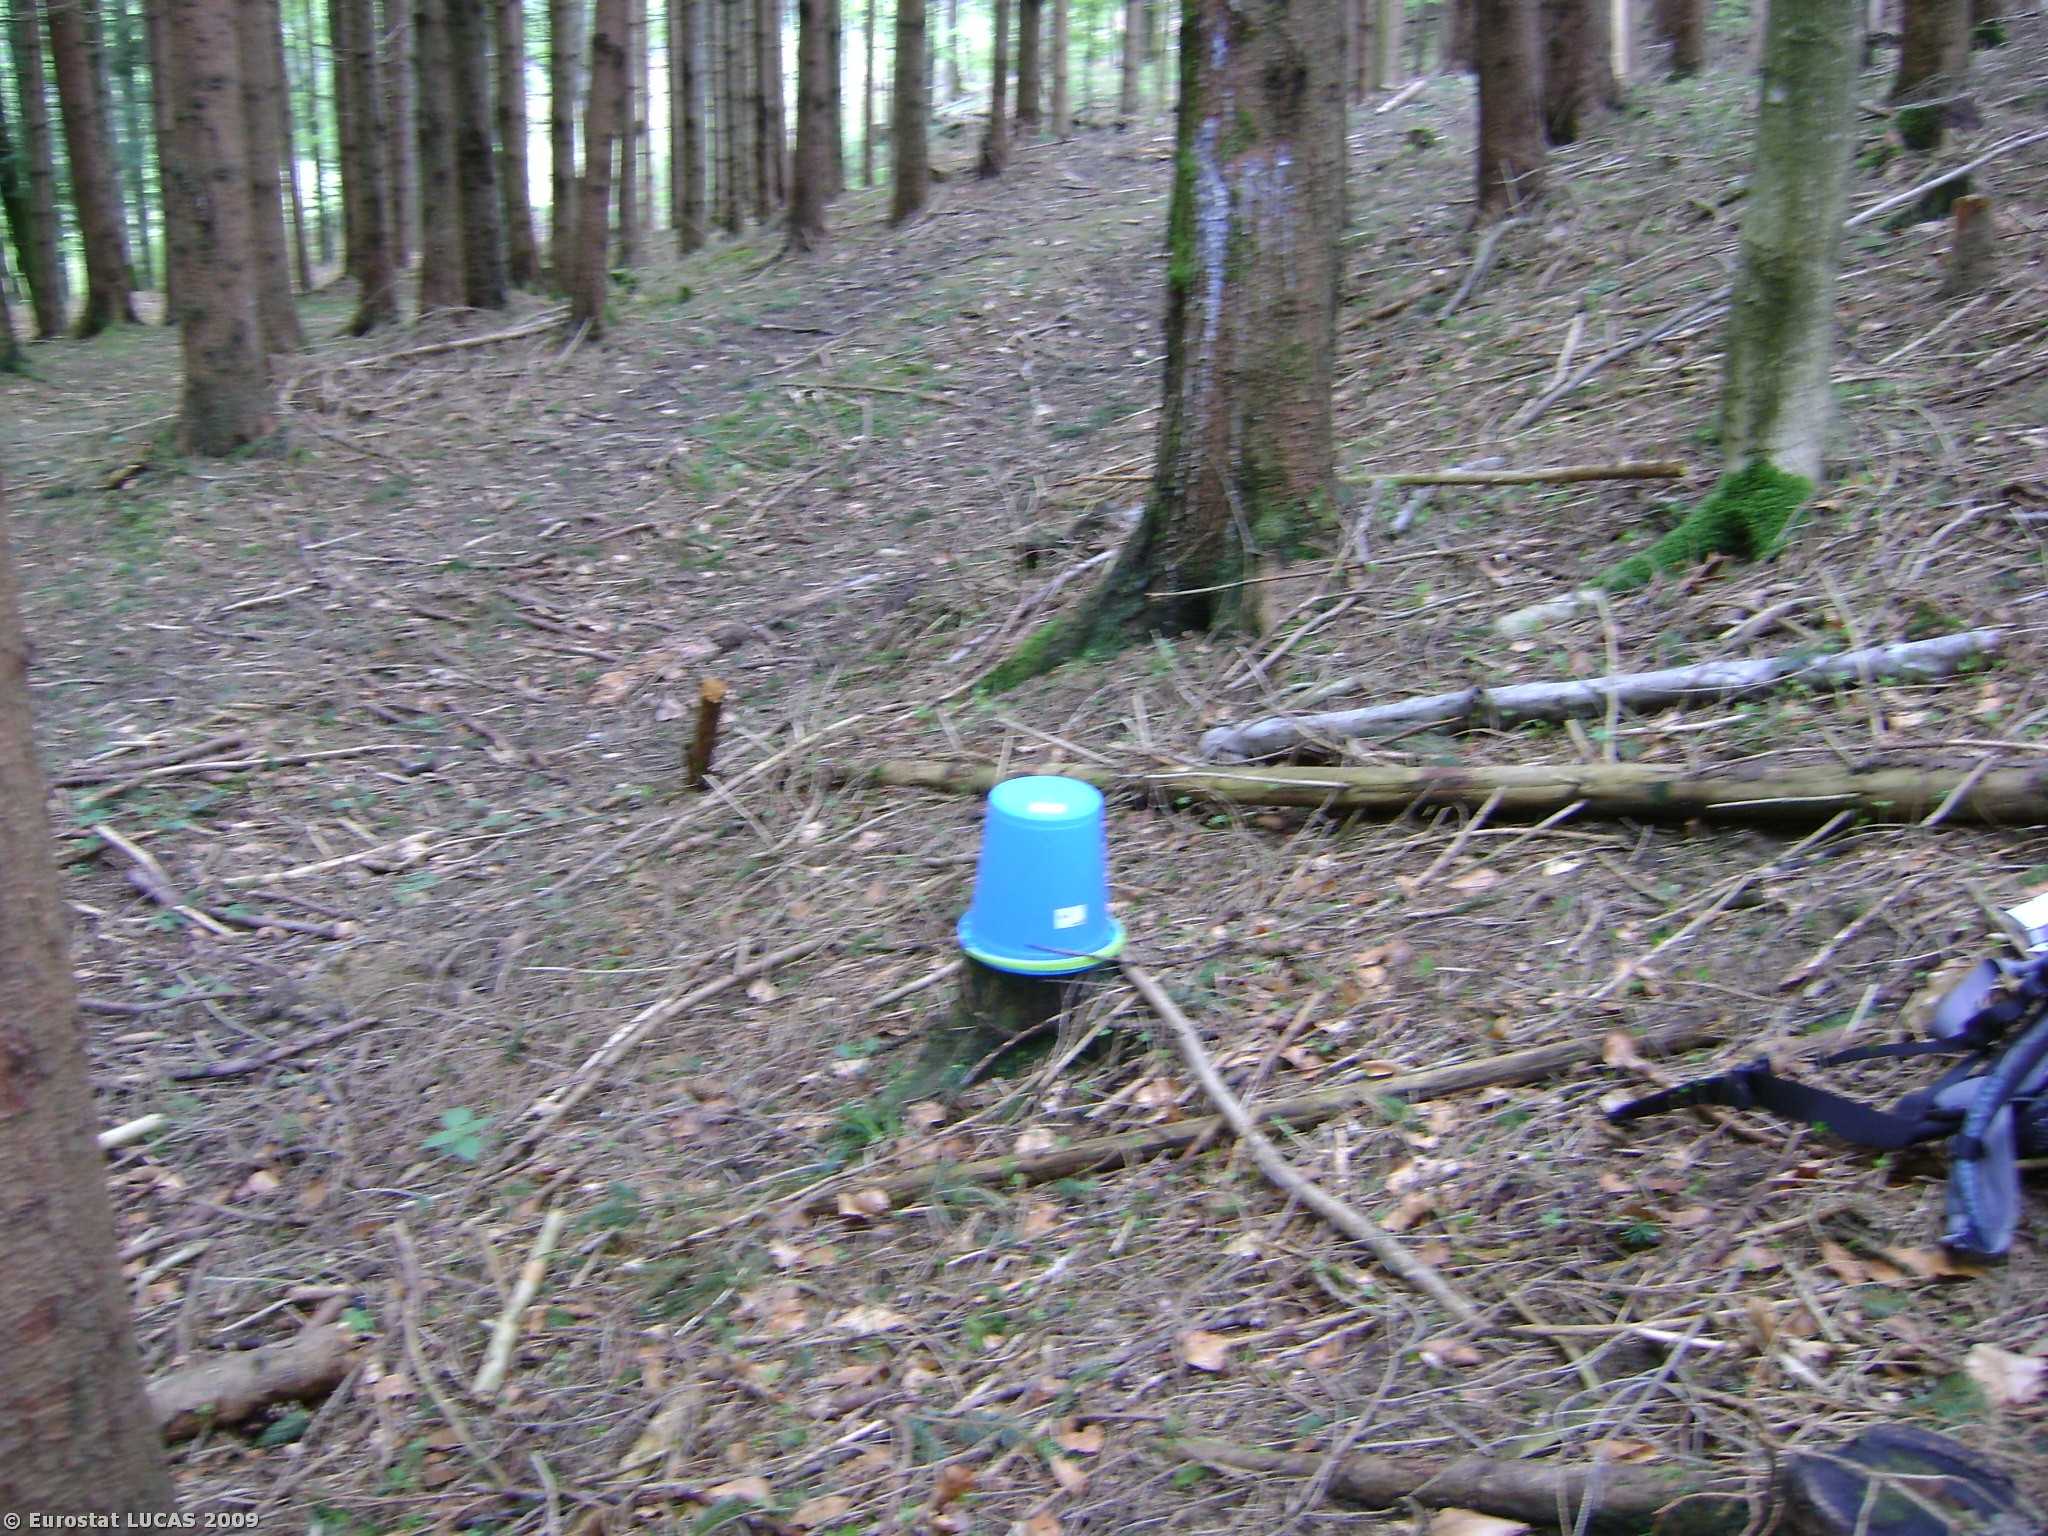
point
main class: Woodland
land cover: Mixed woodland
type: hemiboreal forest and nemoral coniferous forest and mixed broadleaved-coniferous forest
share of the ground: > 75 %
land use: Forestry
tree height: > 5 m
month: May
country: AT
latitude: 47.7805
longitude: 13.2151
